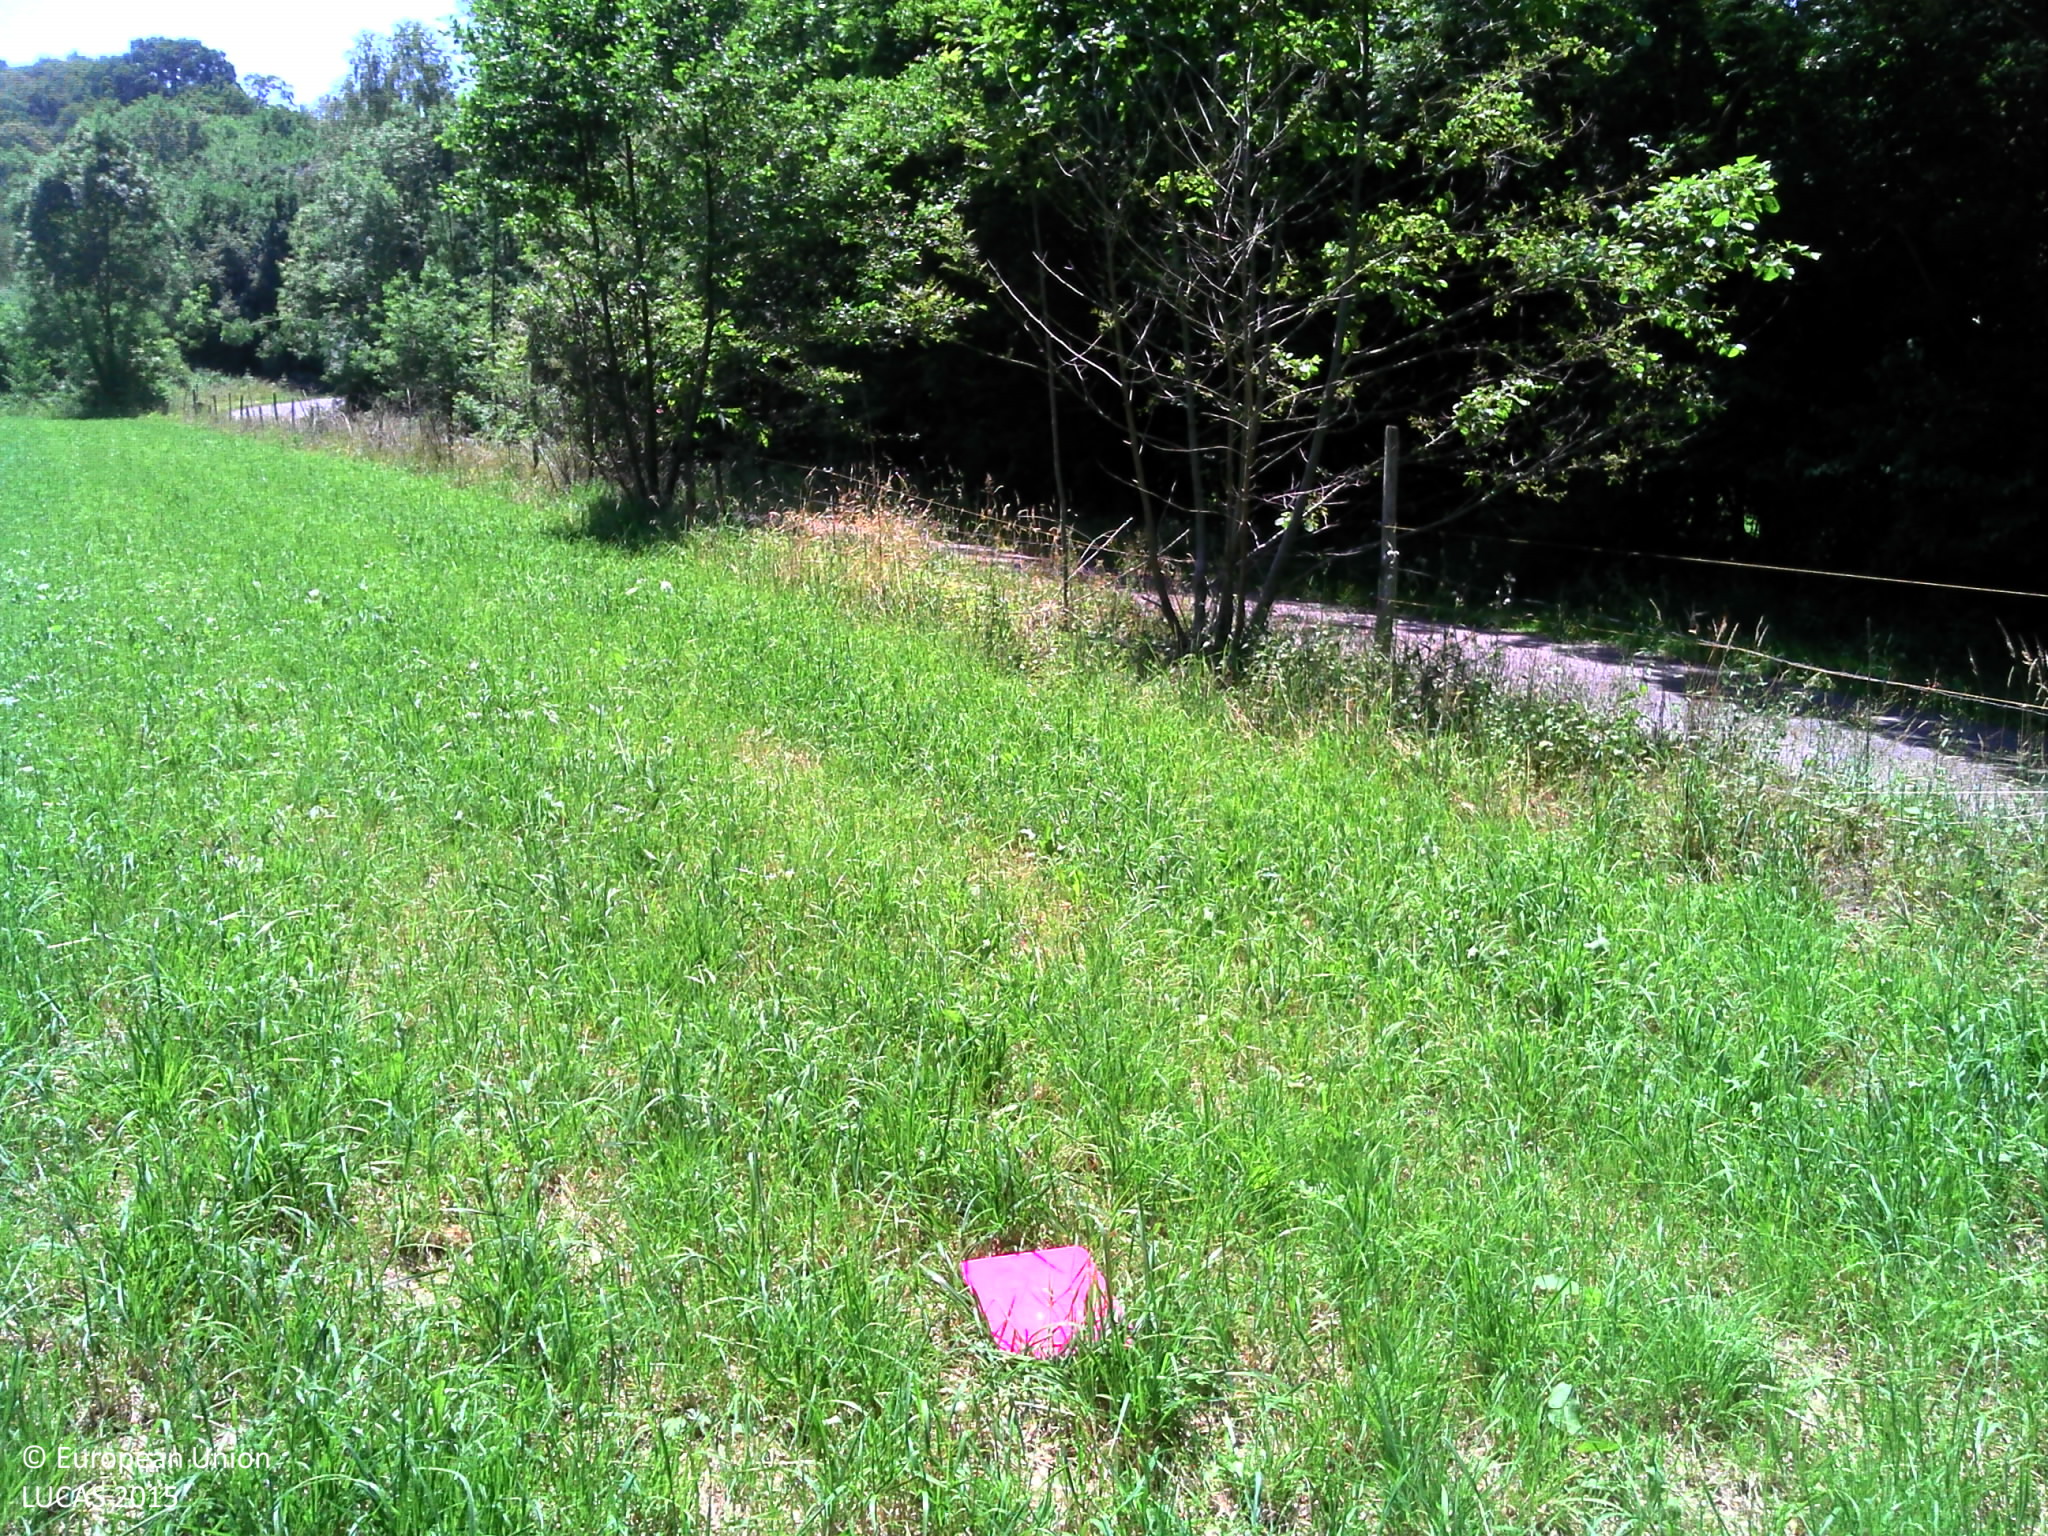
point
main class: Cropland
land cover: Temporary grasslands
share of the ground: > 75 %
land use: Agriculture (excluding fallow land and kitchen gardens)
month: June
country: FR
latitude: 43.1635
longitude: -0.1264
